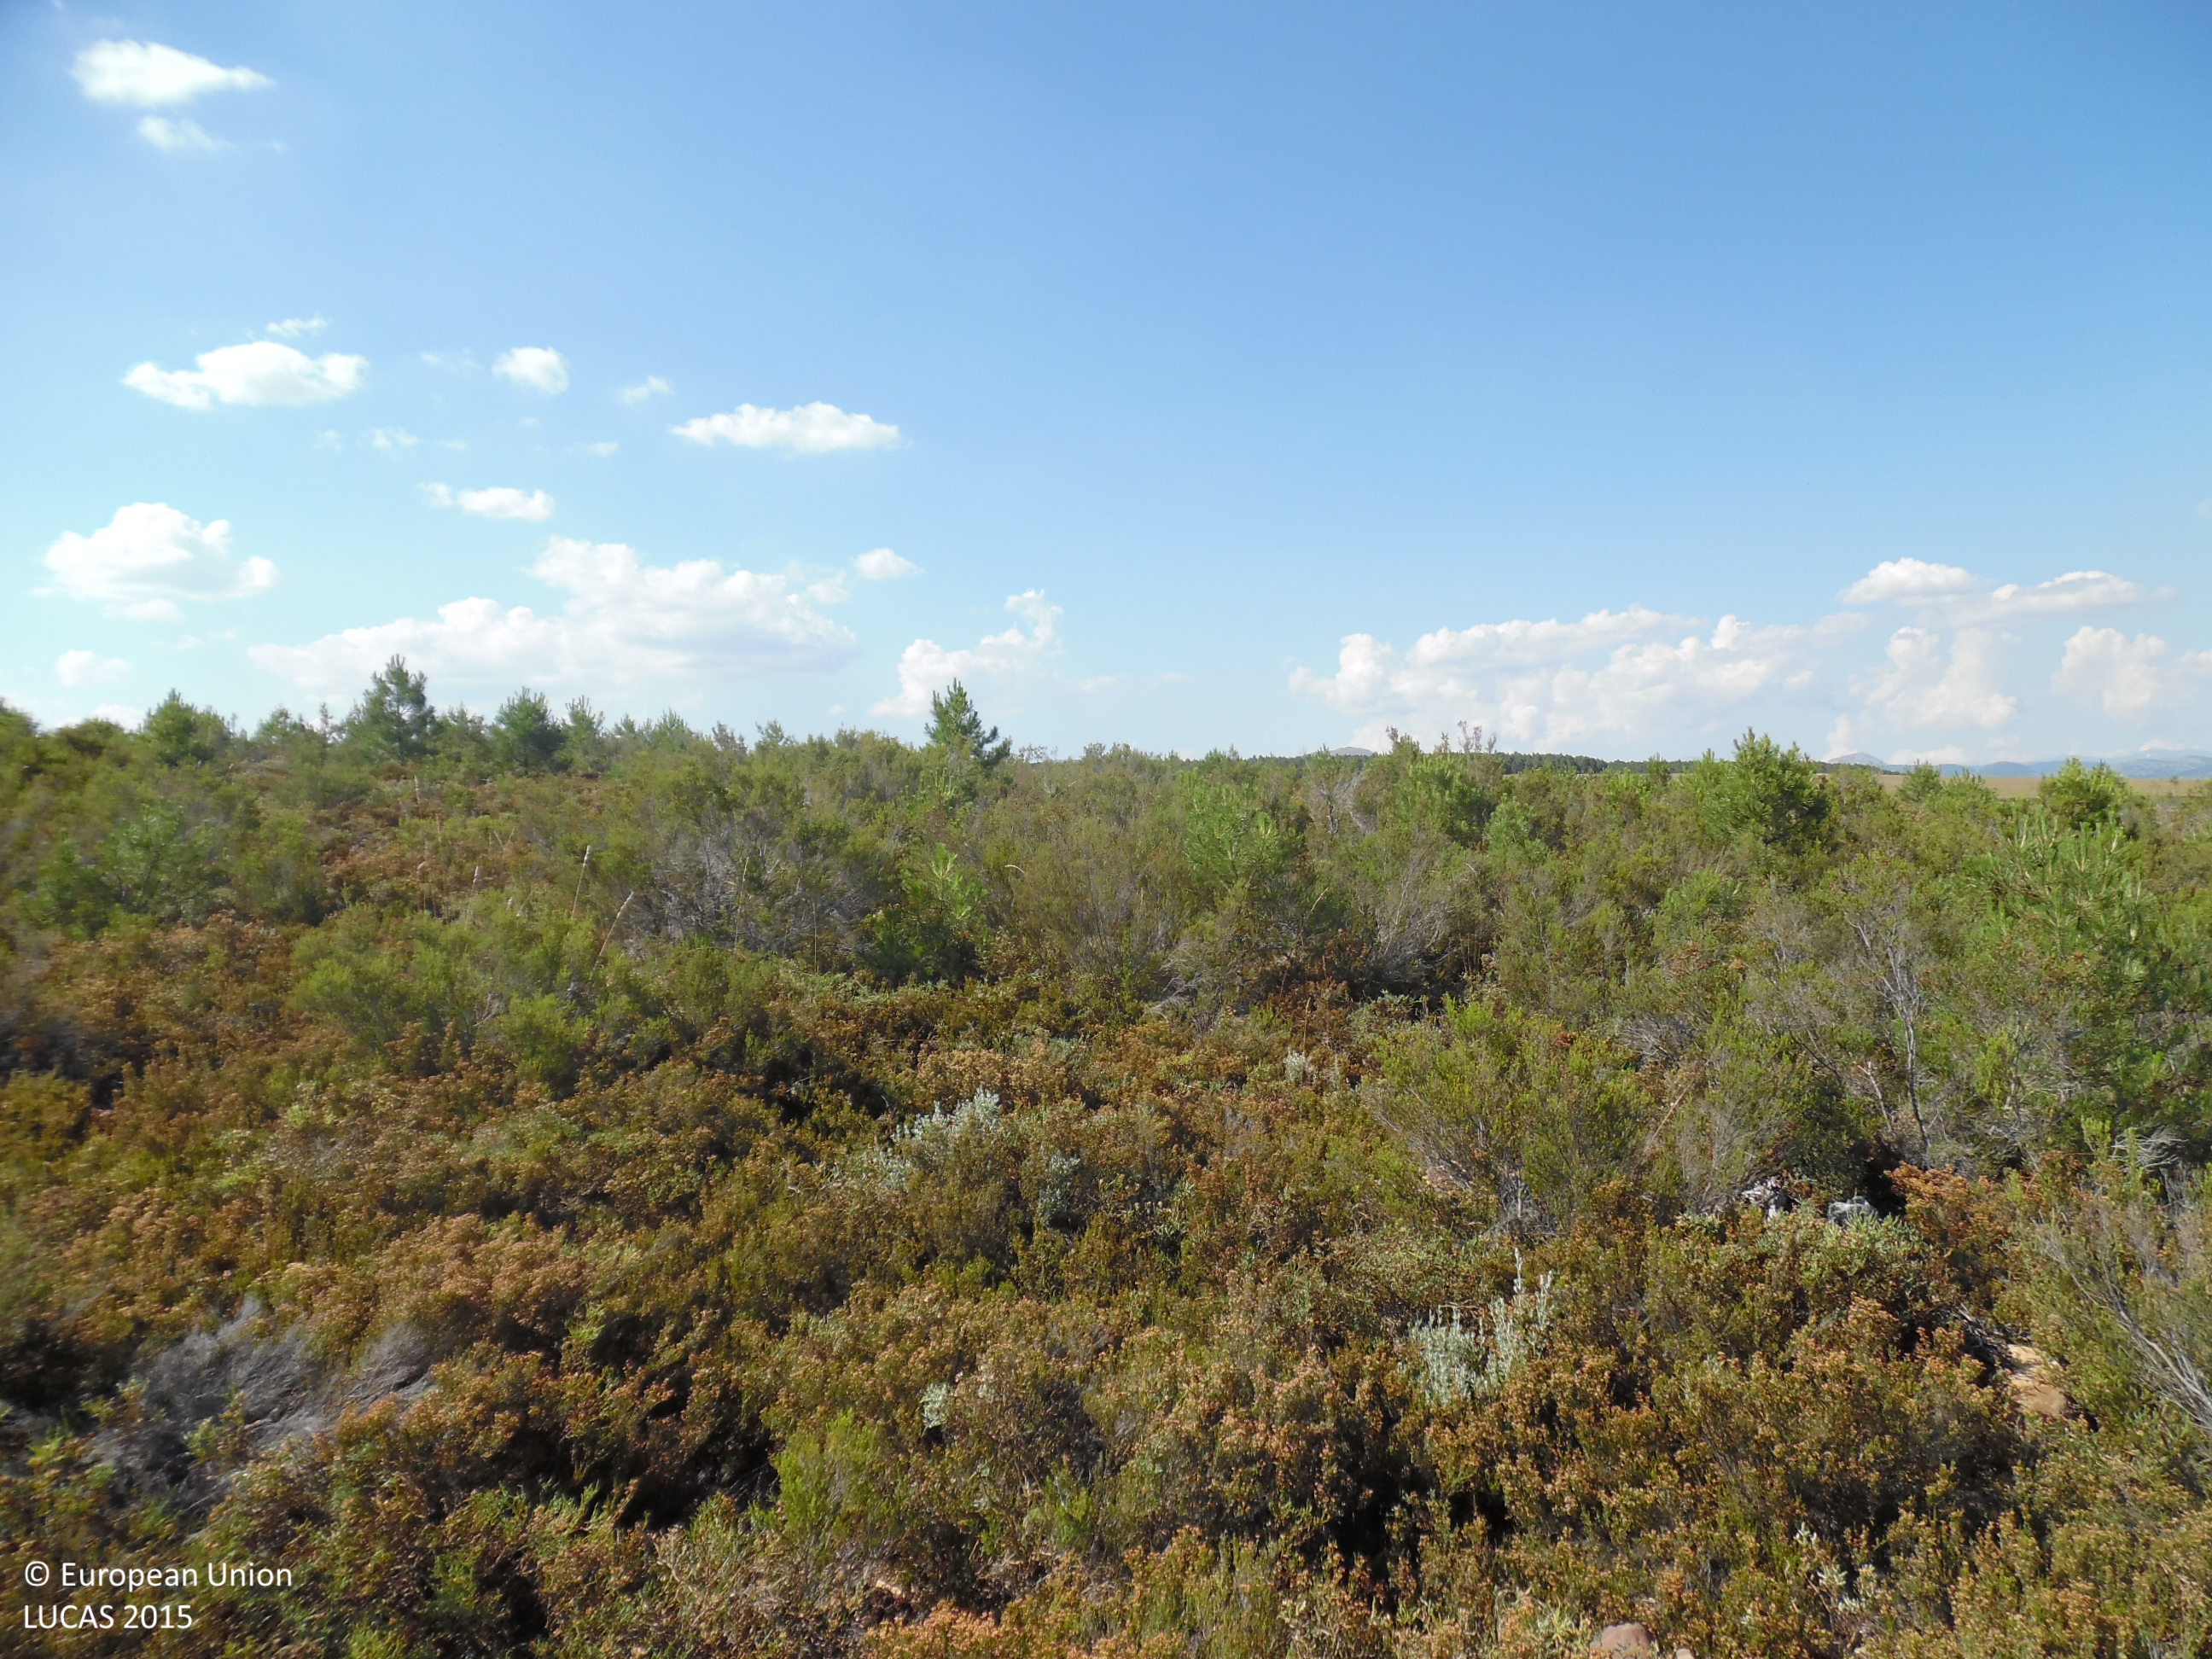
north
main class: Shrubland
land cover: Shrubland without tree cover
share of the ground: > 75 %
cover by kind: shrubs 100 %
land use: Forestry
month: June
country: ES
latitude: 42.7249
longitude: -5.6966
